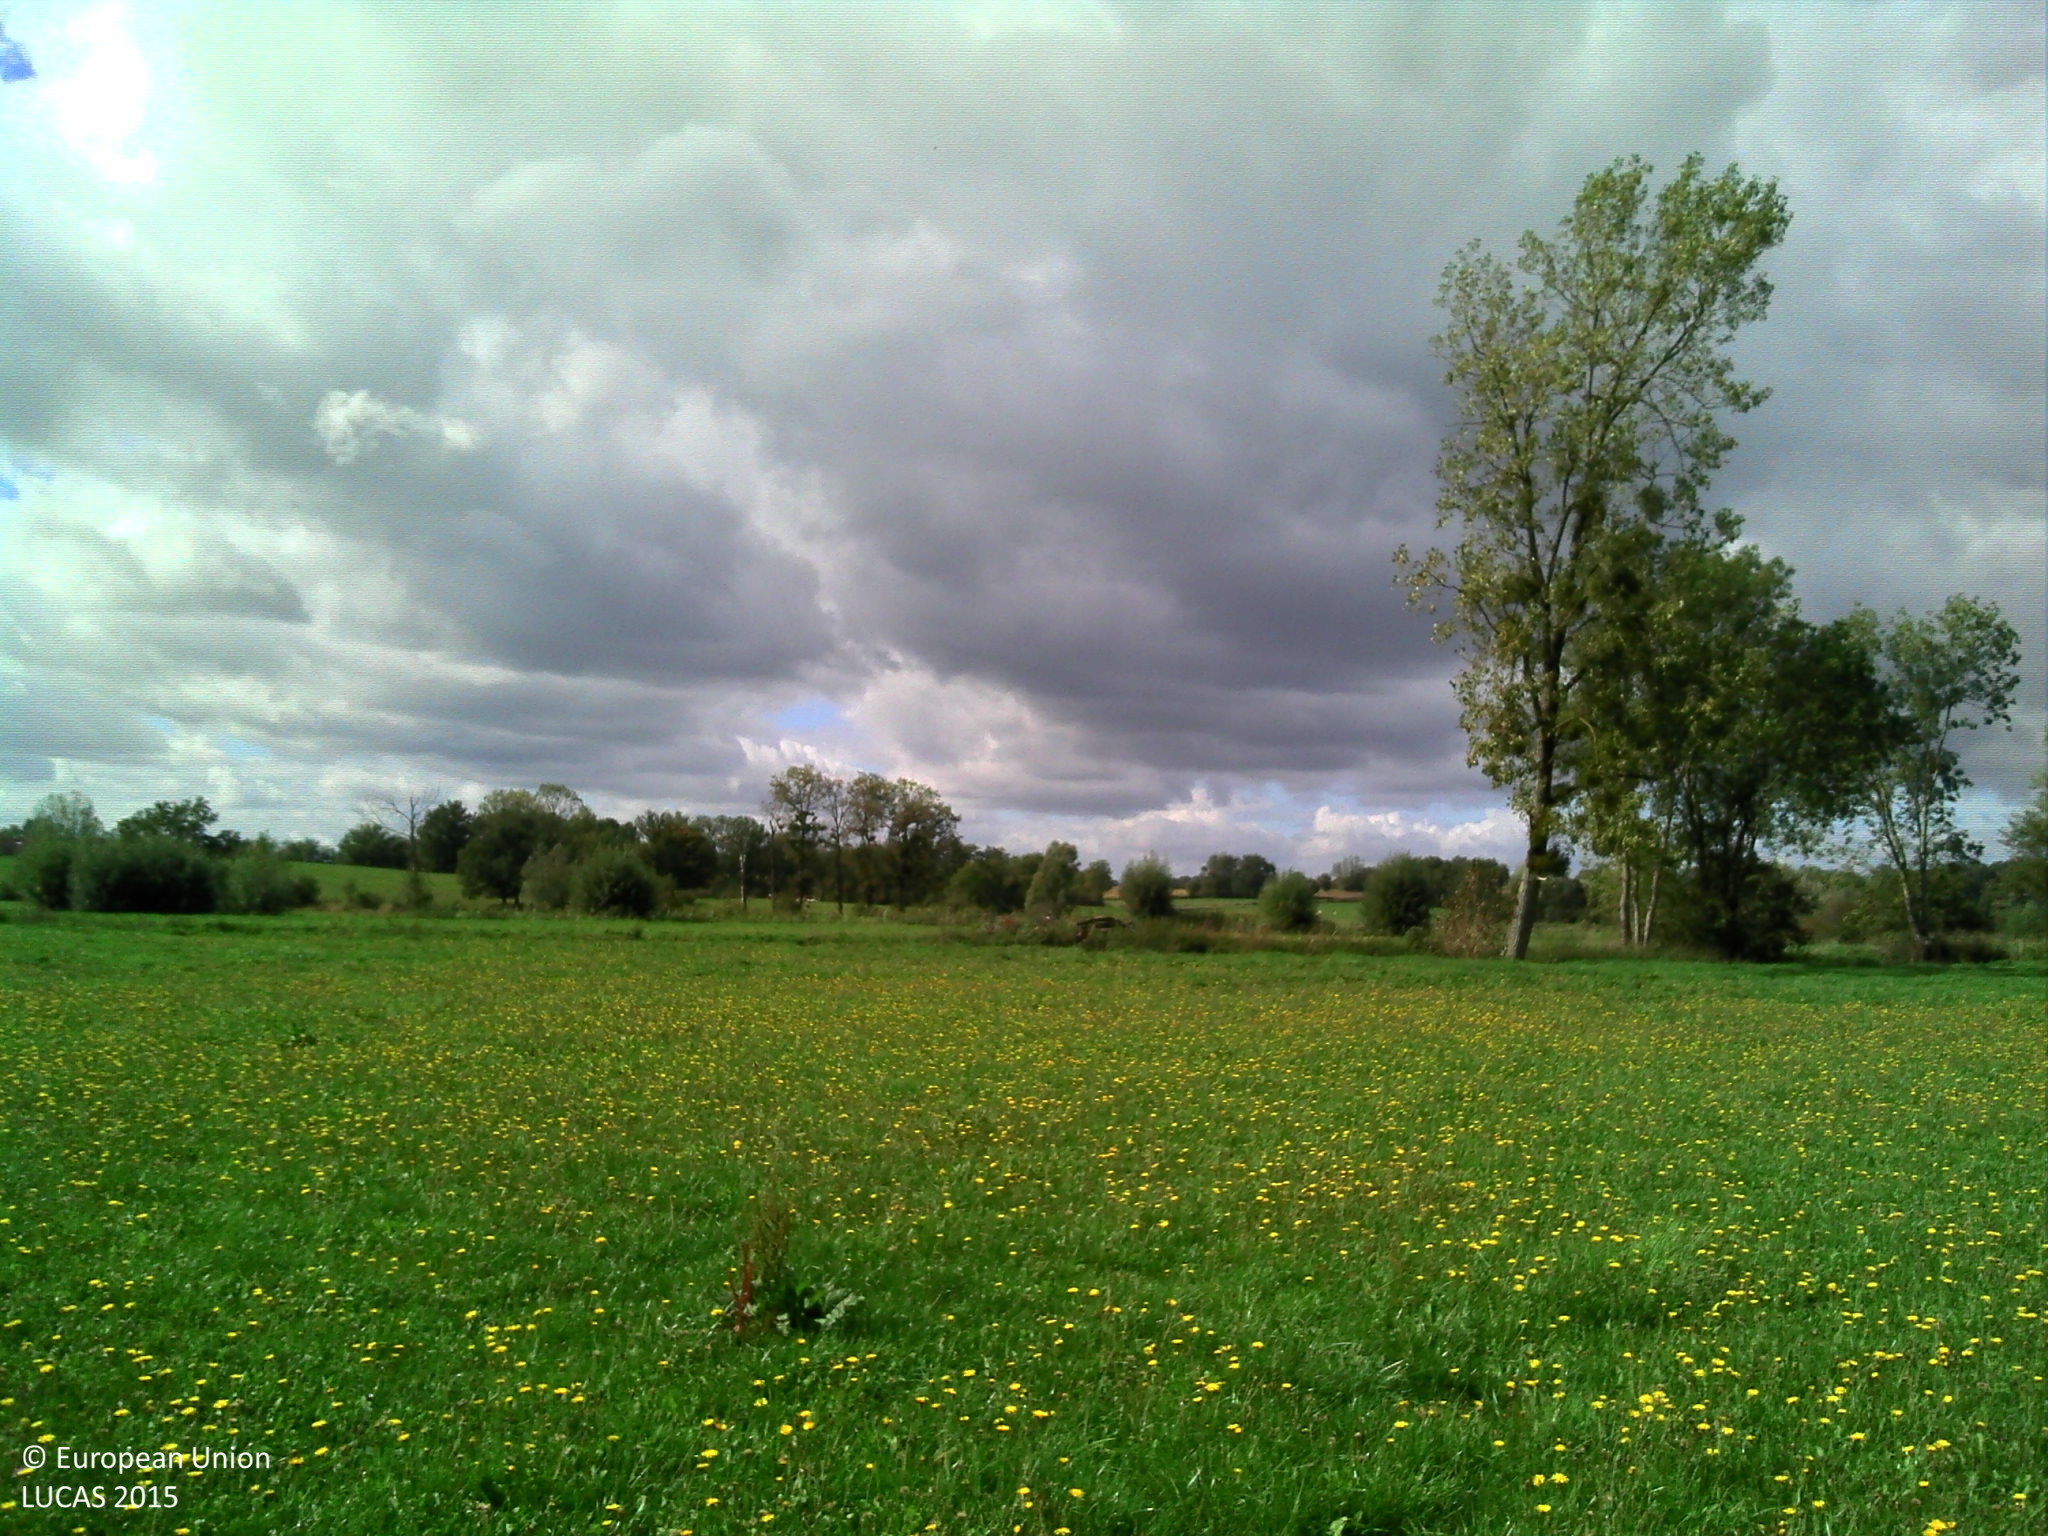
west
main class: Grassland
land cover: Grassland without tree/shrub cover
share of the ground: > 75 %
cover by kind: herbaceous plants 100 %
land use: Agriculture (excluding fallow land and kitchen gardens)
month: October
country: FR
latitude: 46.3903
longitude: 5.2561
